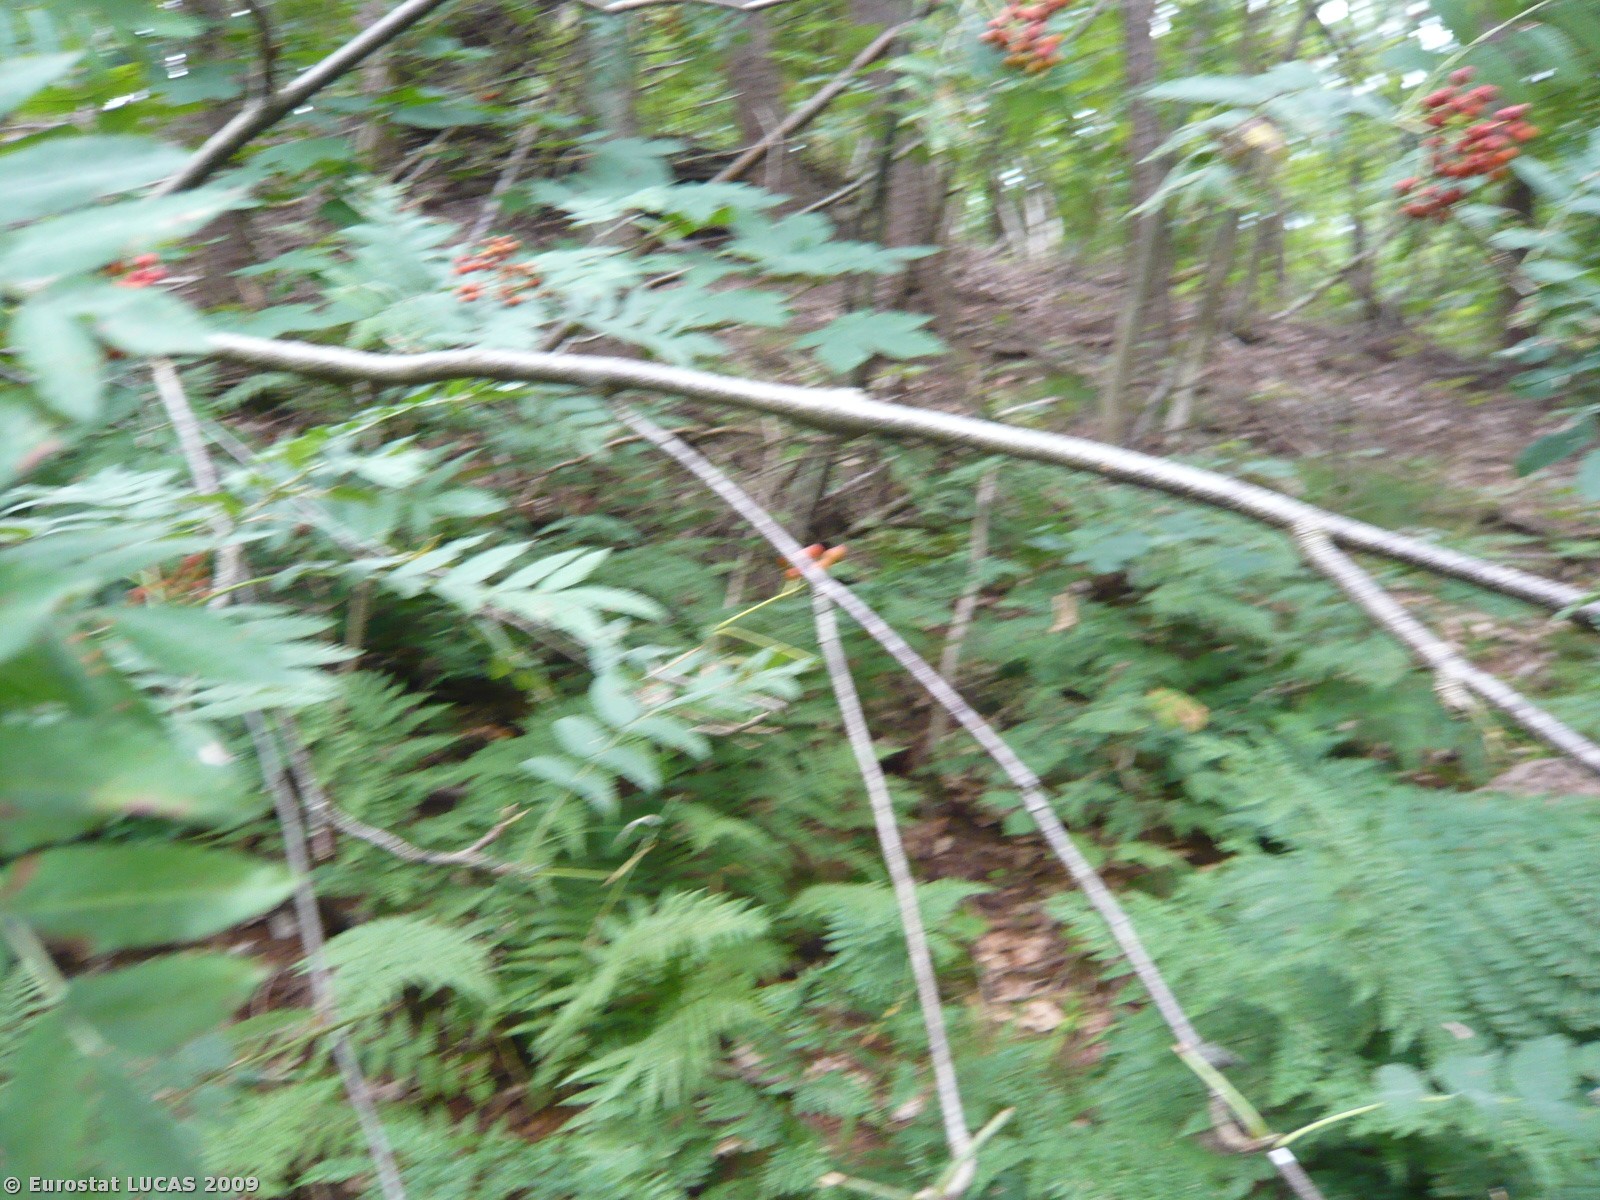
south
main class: Woodland
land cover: Coniferous woodland
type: hemiboreal forest and nemoral coniferous forest and mixed broadleaved-coniferous forest
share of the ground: > 75 %
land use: Amenities, museums, leisure
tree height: > 5 m
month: August
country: DK
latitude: 55.9739
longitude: 12.0331
